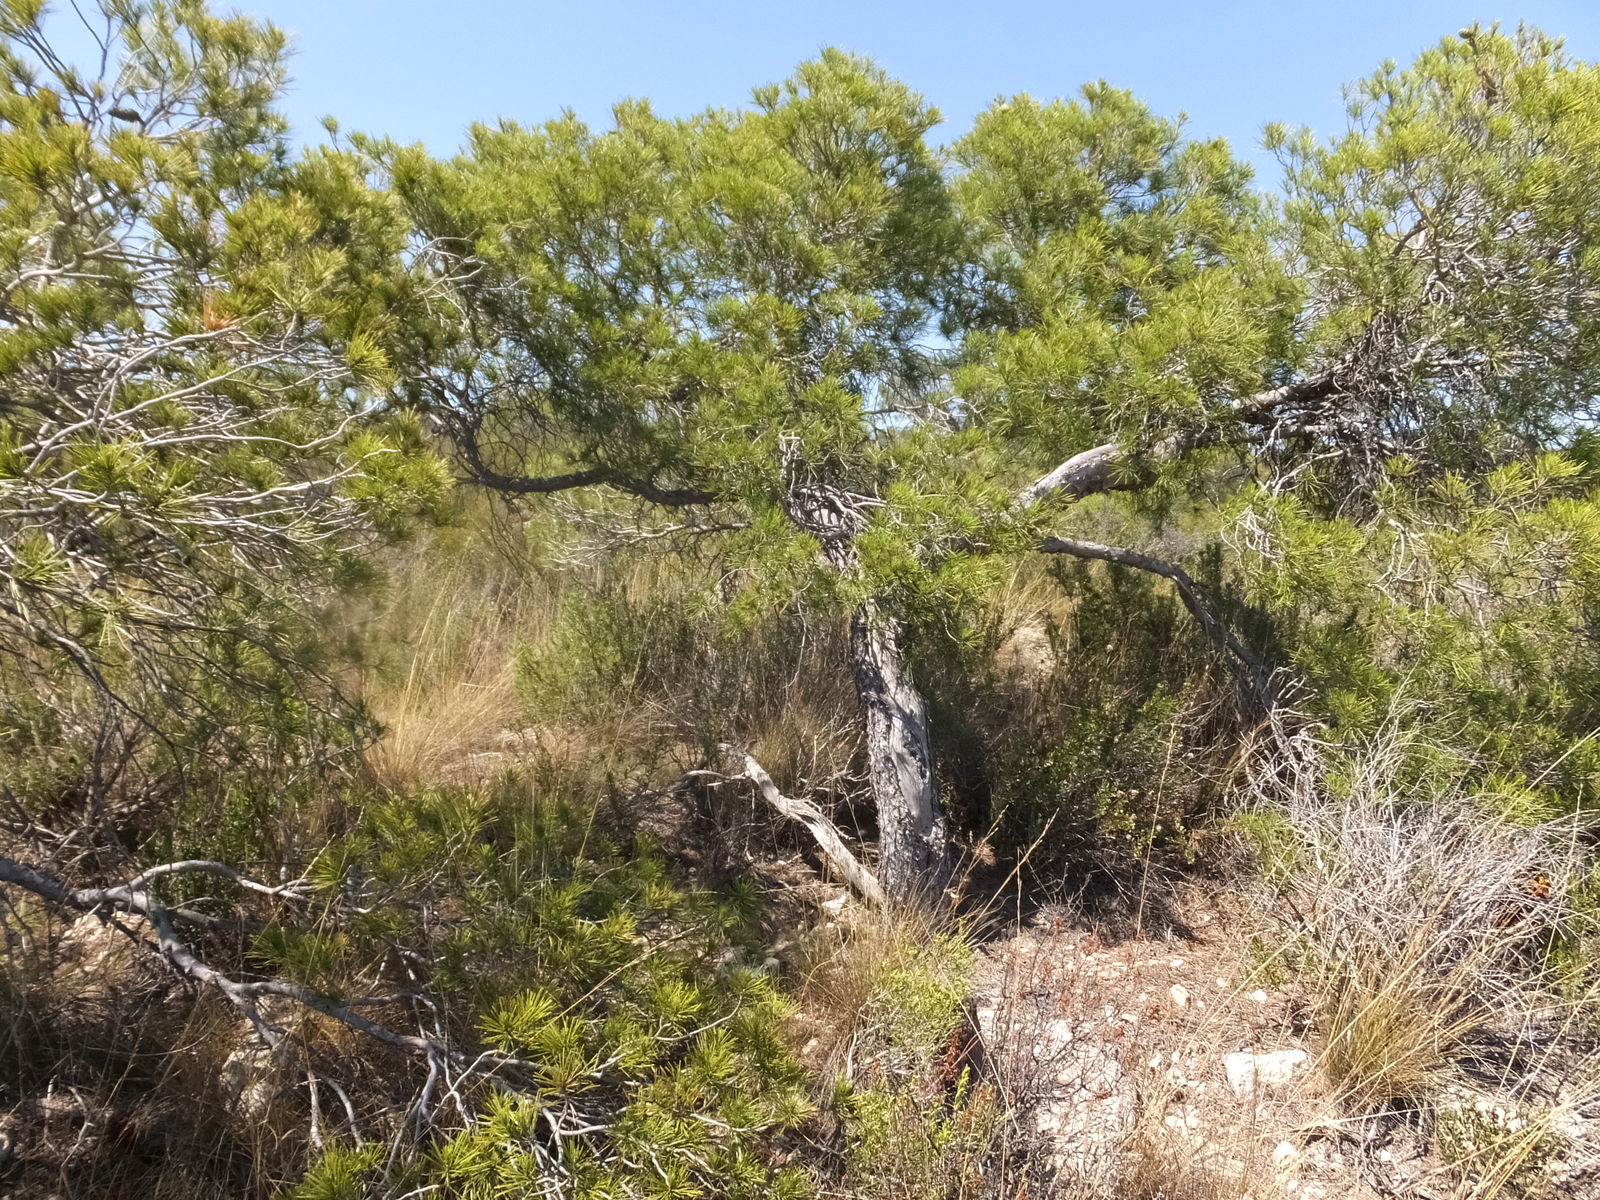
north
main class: Woodland
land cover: Pine dominated mixed woodland
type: coniferous forest of the mediterranean region
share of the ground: 25 - 50 %
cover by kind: shrubs 35 %, coniferous forest trees 25 %, herbaceous plants 25 %, broadleaved forest trees 15 %
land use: Forestry
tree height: > 5 m
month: June
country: ES
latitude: 41.3509
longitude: -0.0654
